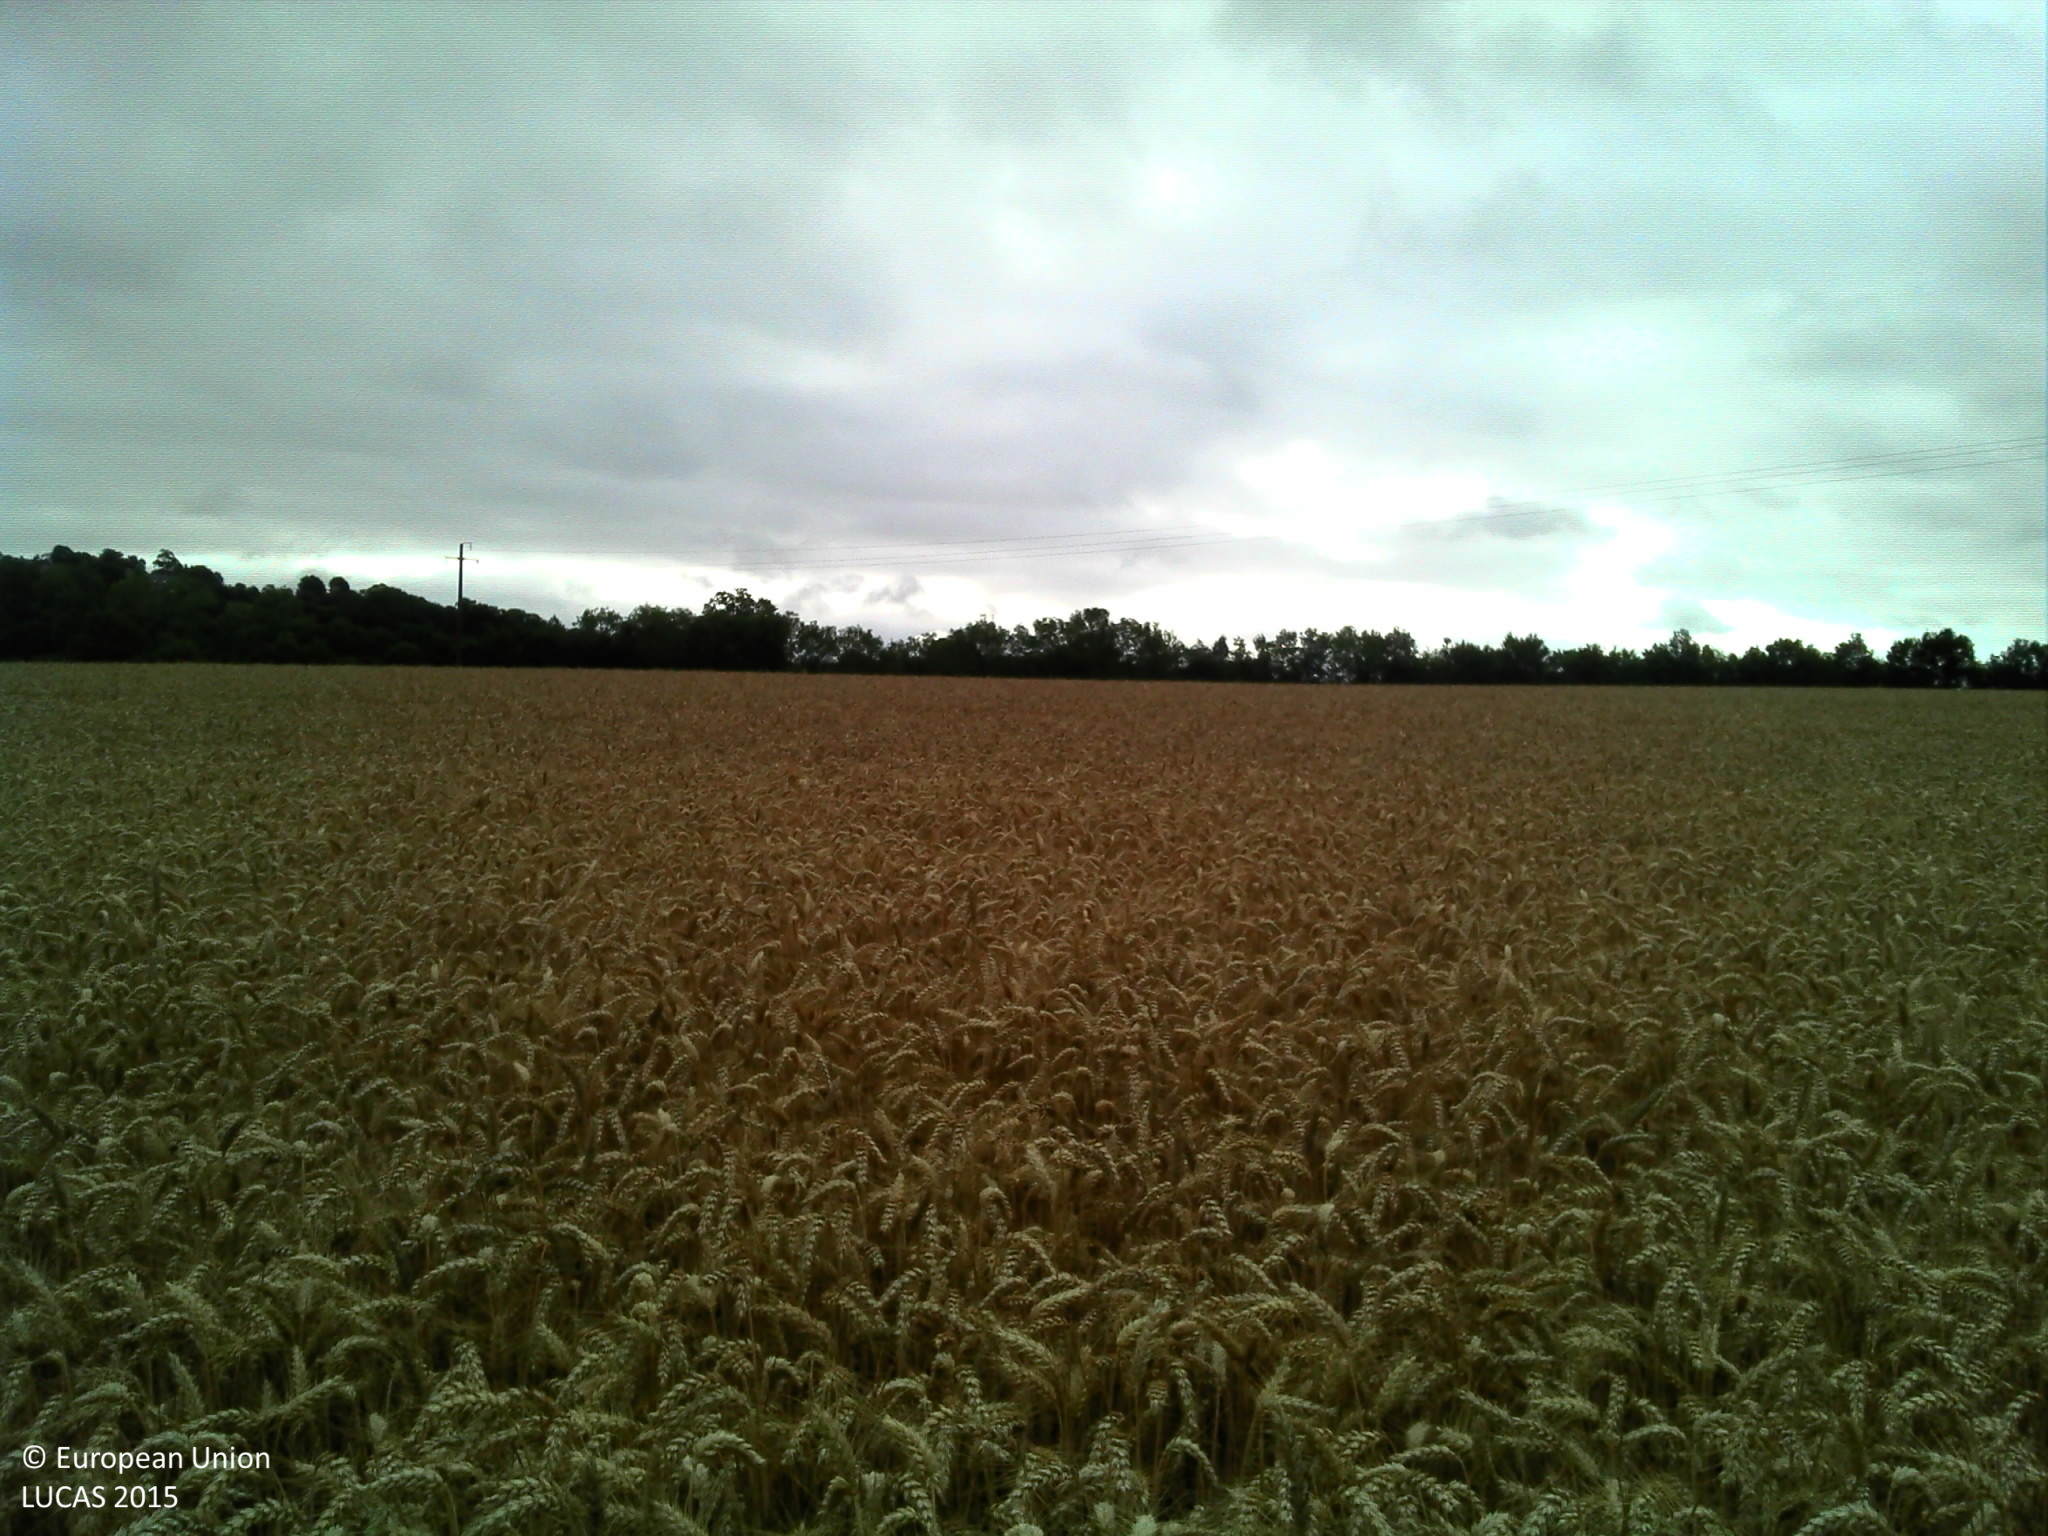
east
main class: Cropland
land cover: Common wheat
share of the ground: > 75 %
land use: Agriculture (excluding fallow land and kitchen gardens)
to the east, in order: Common wheat; Electric lines; Common wheat; Abandoned hedges; Grass margins; Other cereals
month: July
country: FR
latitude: 47.8475
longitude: -1.5781
